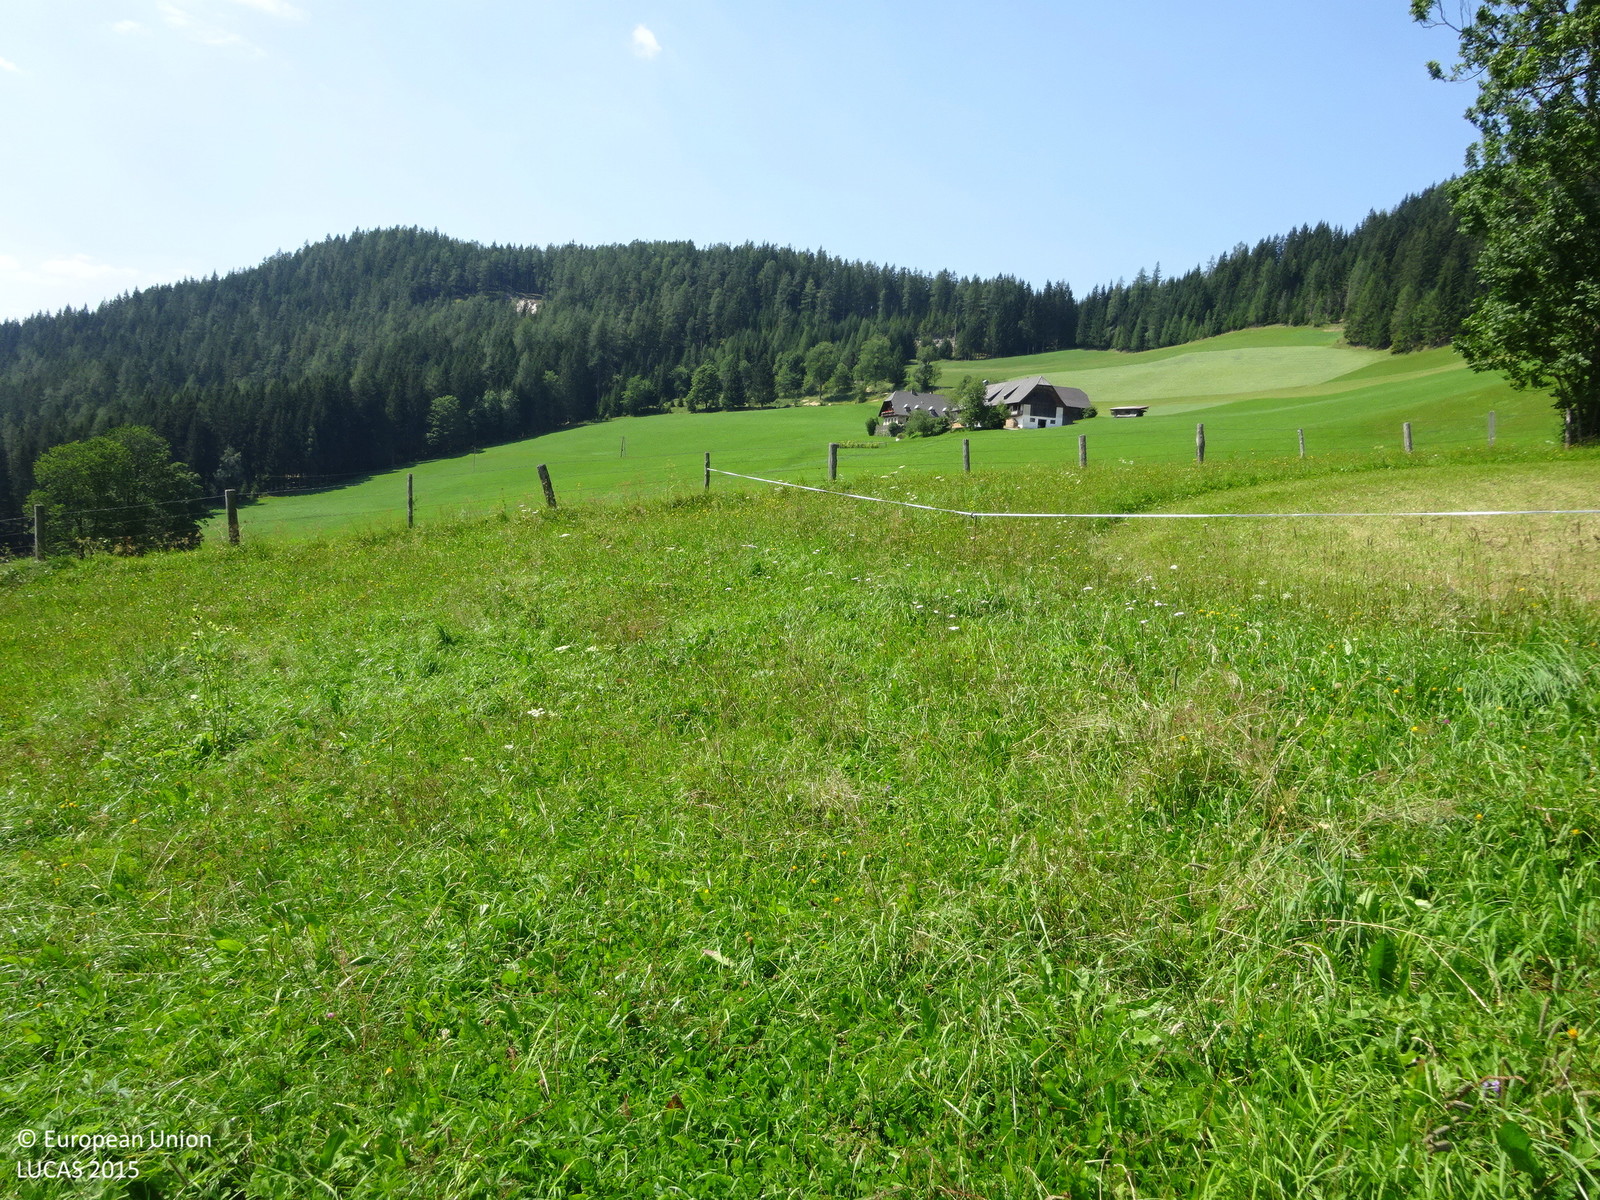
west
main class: Grassland
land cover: Grassland without tree/shrub cover
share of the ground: > 75 %
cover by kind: herbaceous plants 100 %
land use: Agriculture (excluding fallow land and kitchen gardens)
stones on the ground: < 10 %
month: August
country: AT
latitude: 47.5292
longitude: 15.8062
